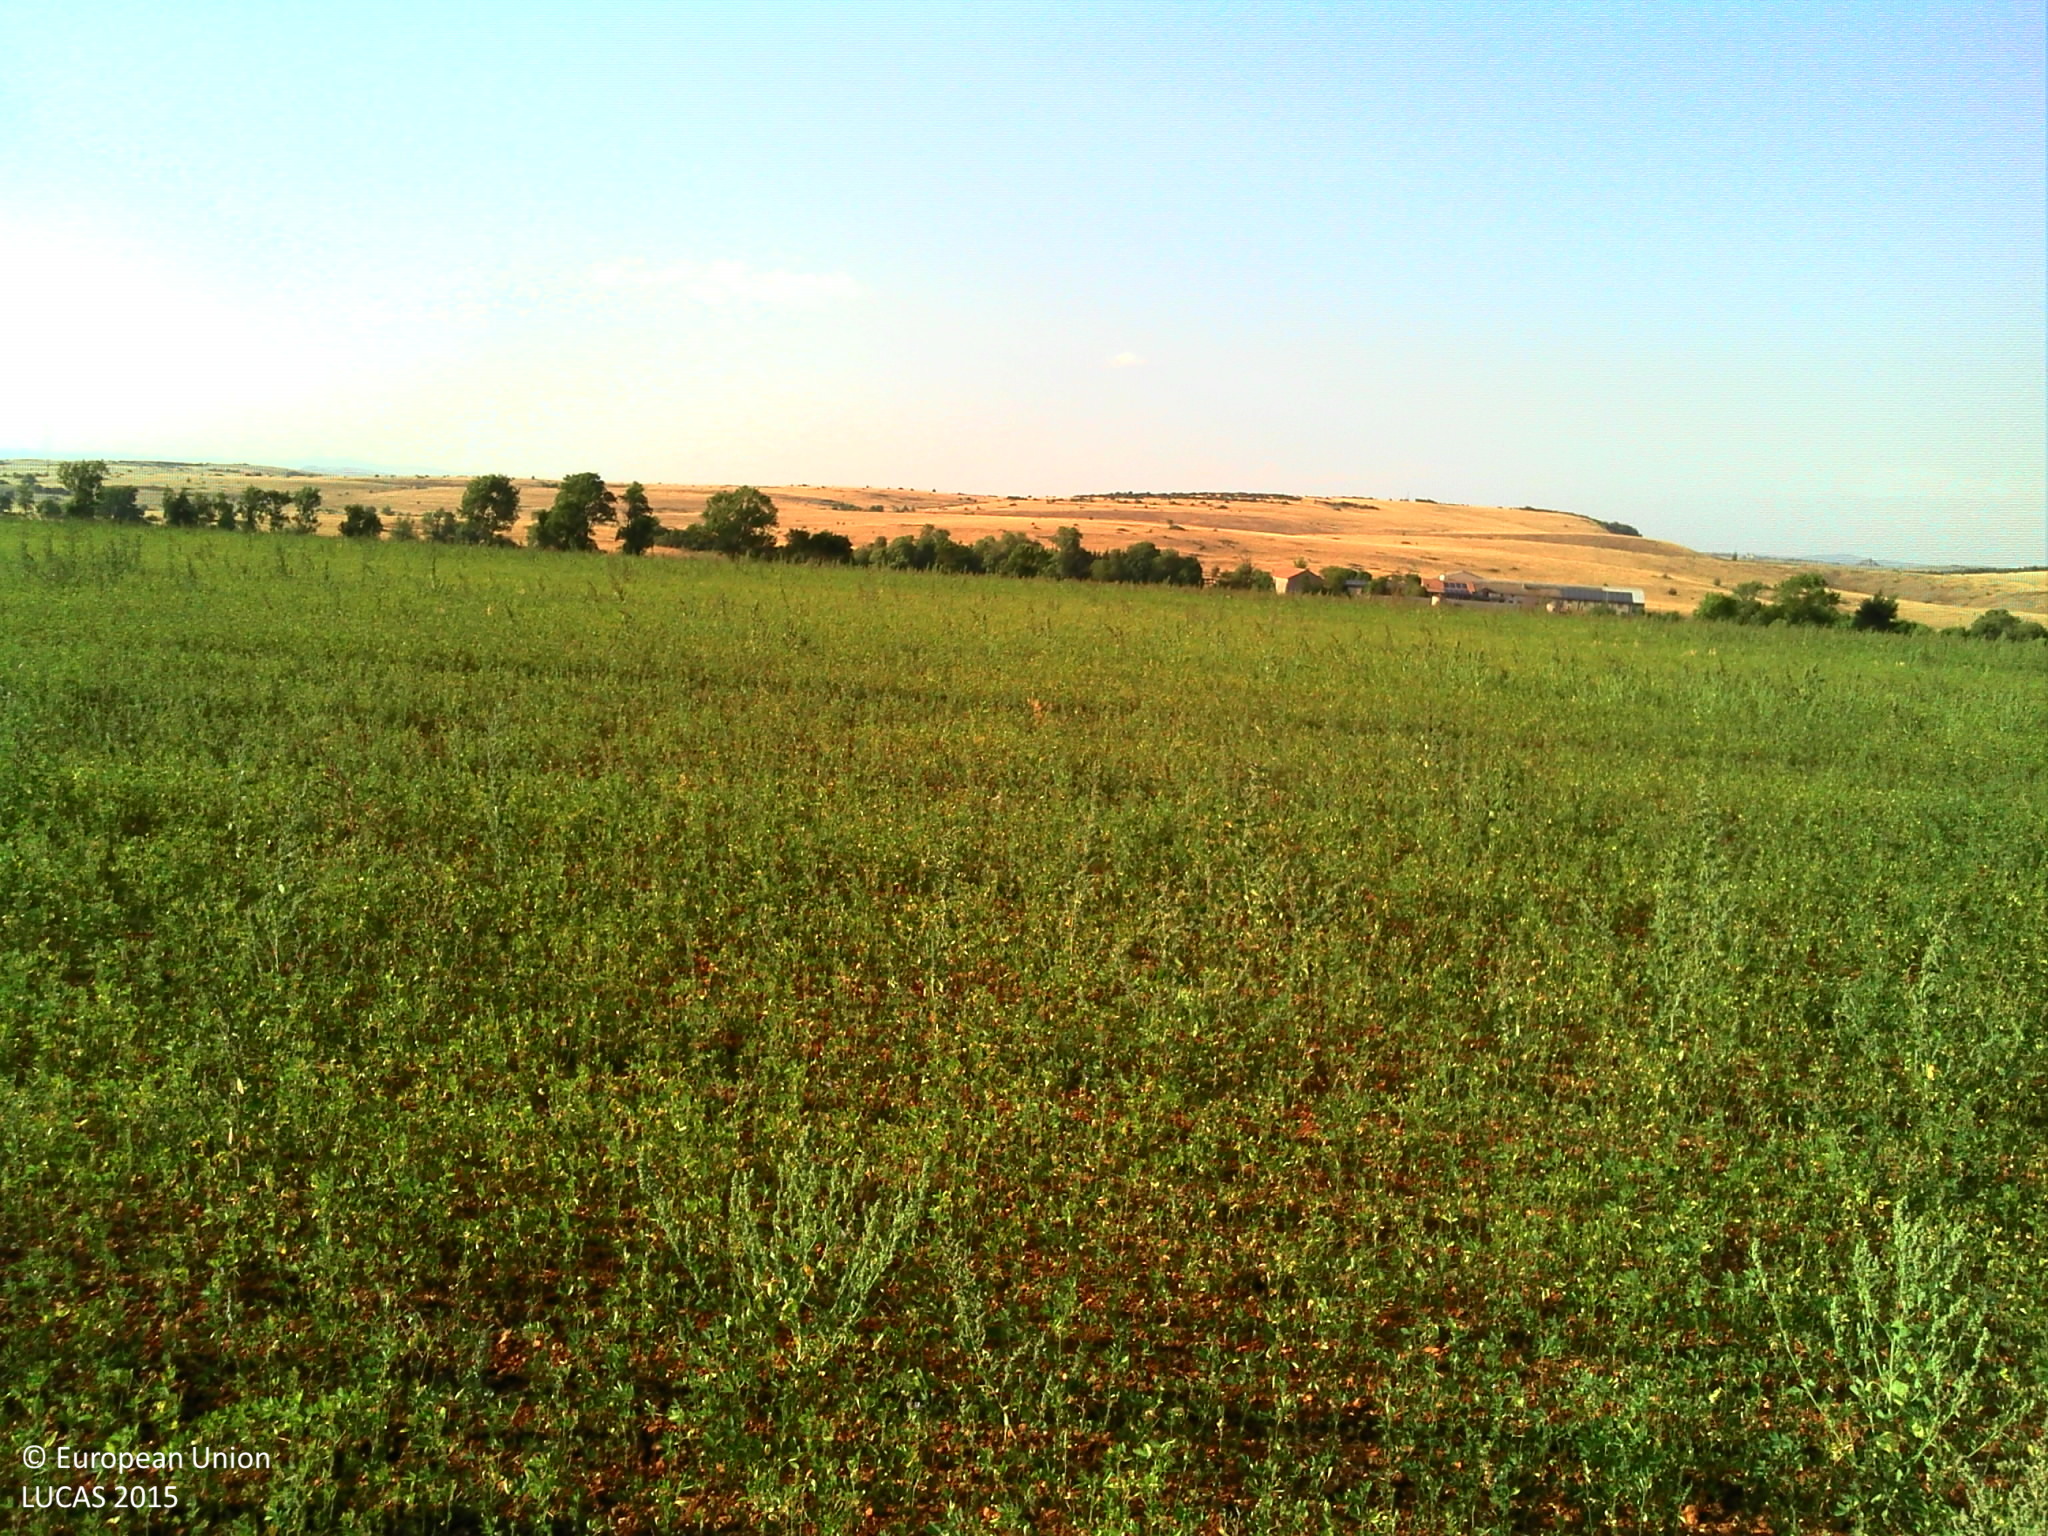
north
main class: Cropland
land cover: Lucerne
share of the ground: 50 - 75 %
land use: Agriculture (excluding fallow land and kitchen gardens)
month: August
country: FR
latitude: 44.0127
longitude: 3.1084
